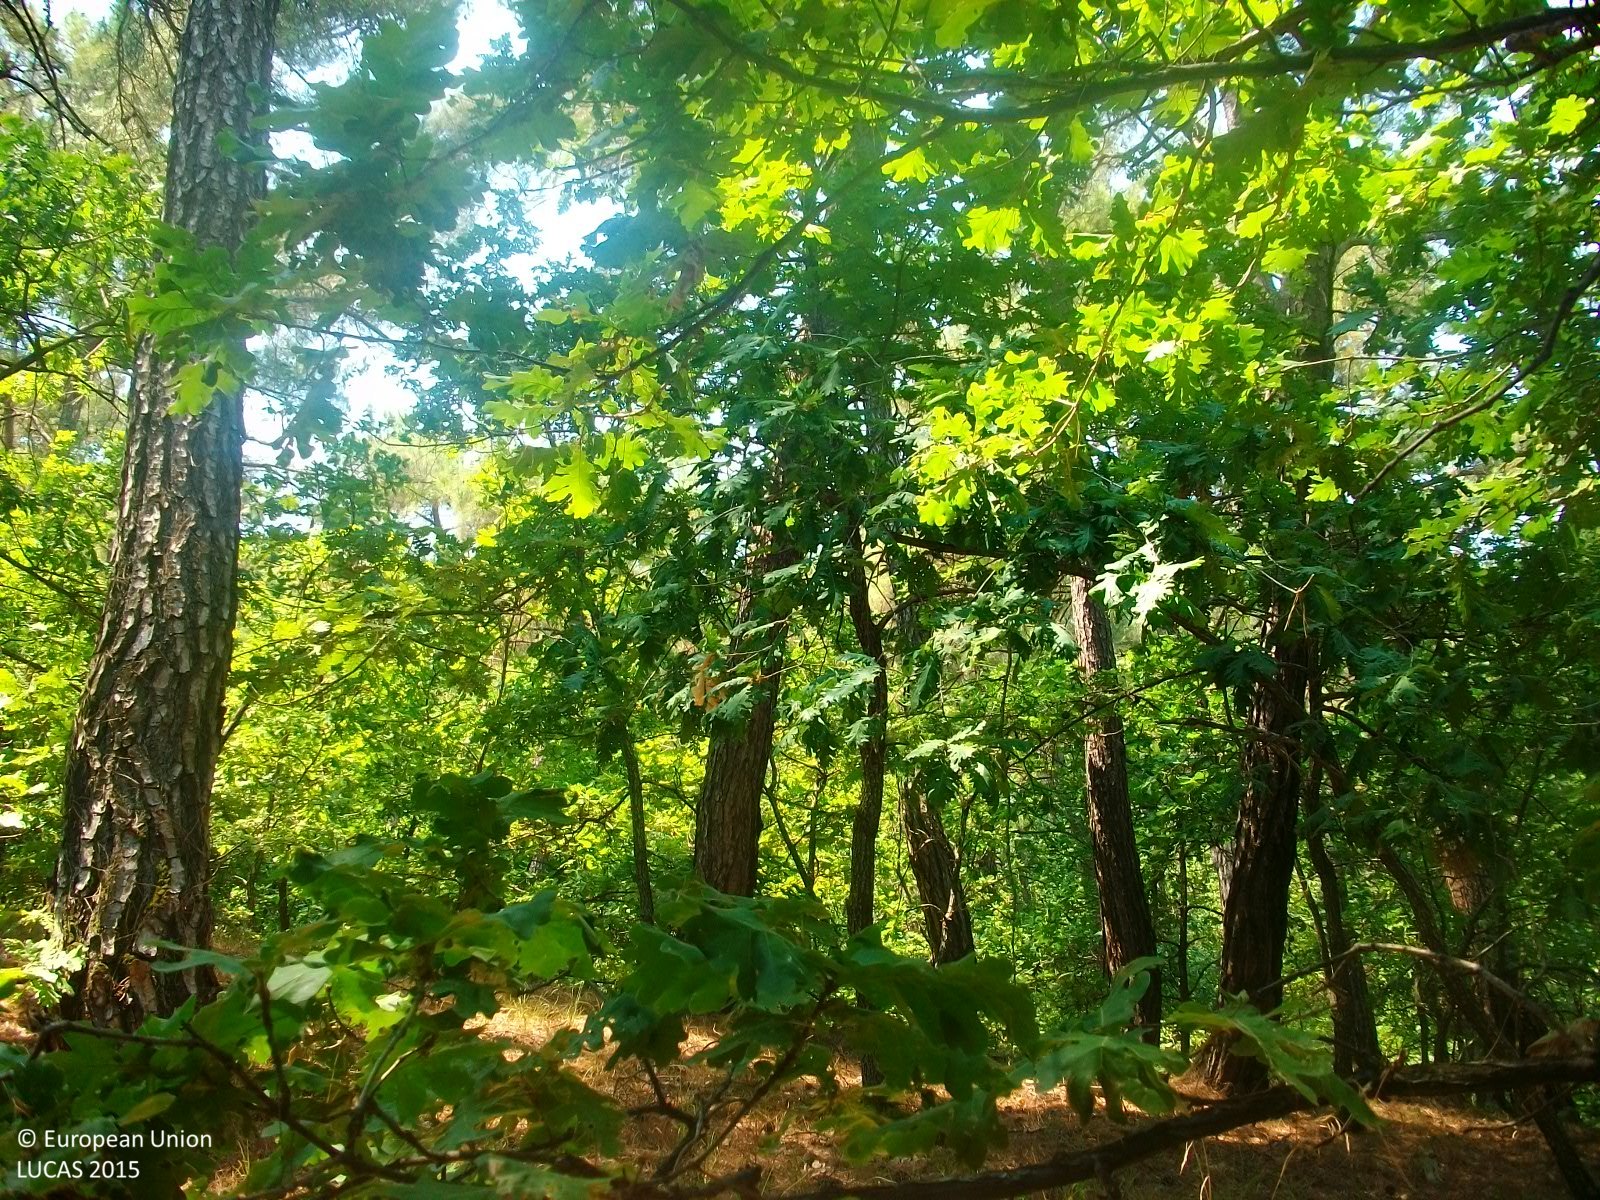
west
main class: Woodland
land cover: Broadleaved woodland
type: thermophilous deciduous forest
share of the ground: > 75 %
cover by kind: broadleaved forest trees 100 %
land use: Forestry
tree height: > 5 m
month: July
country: GR
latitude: 41.1712
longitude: 26.2186
